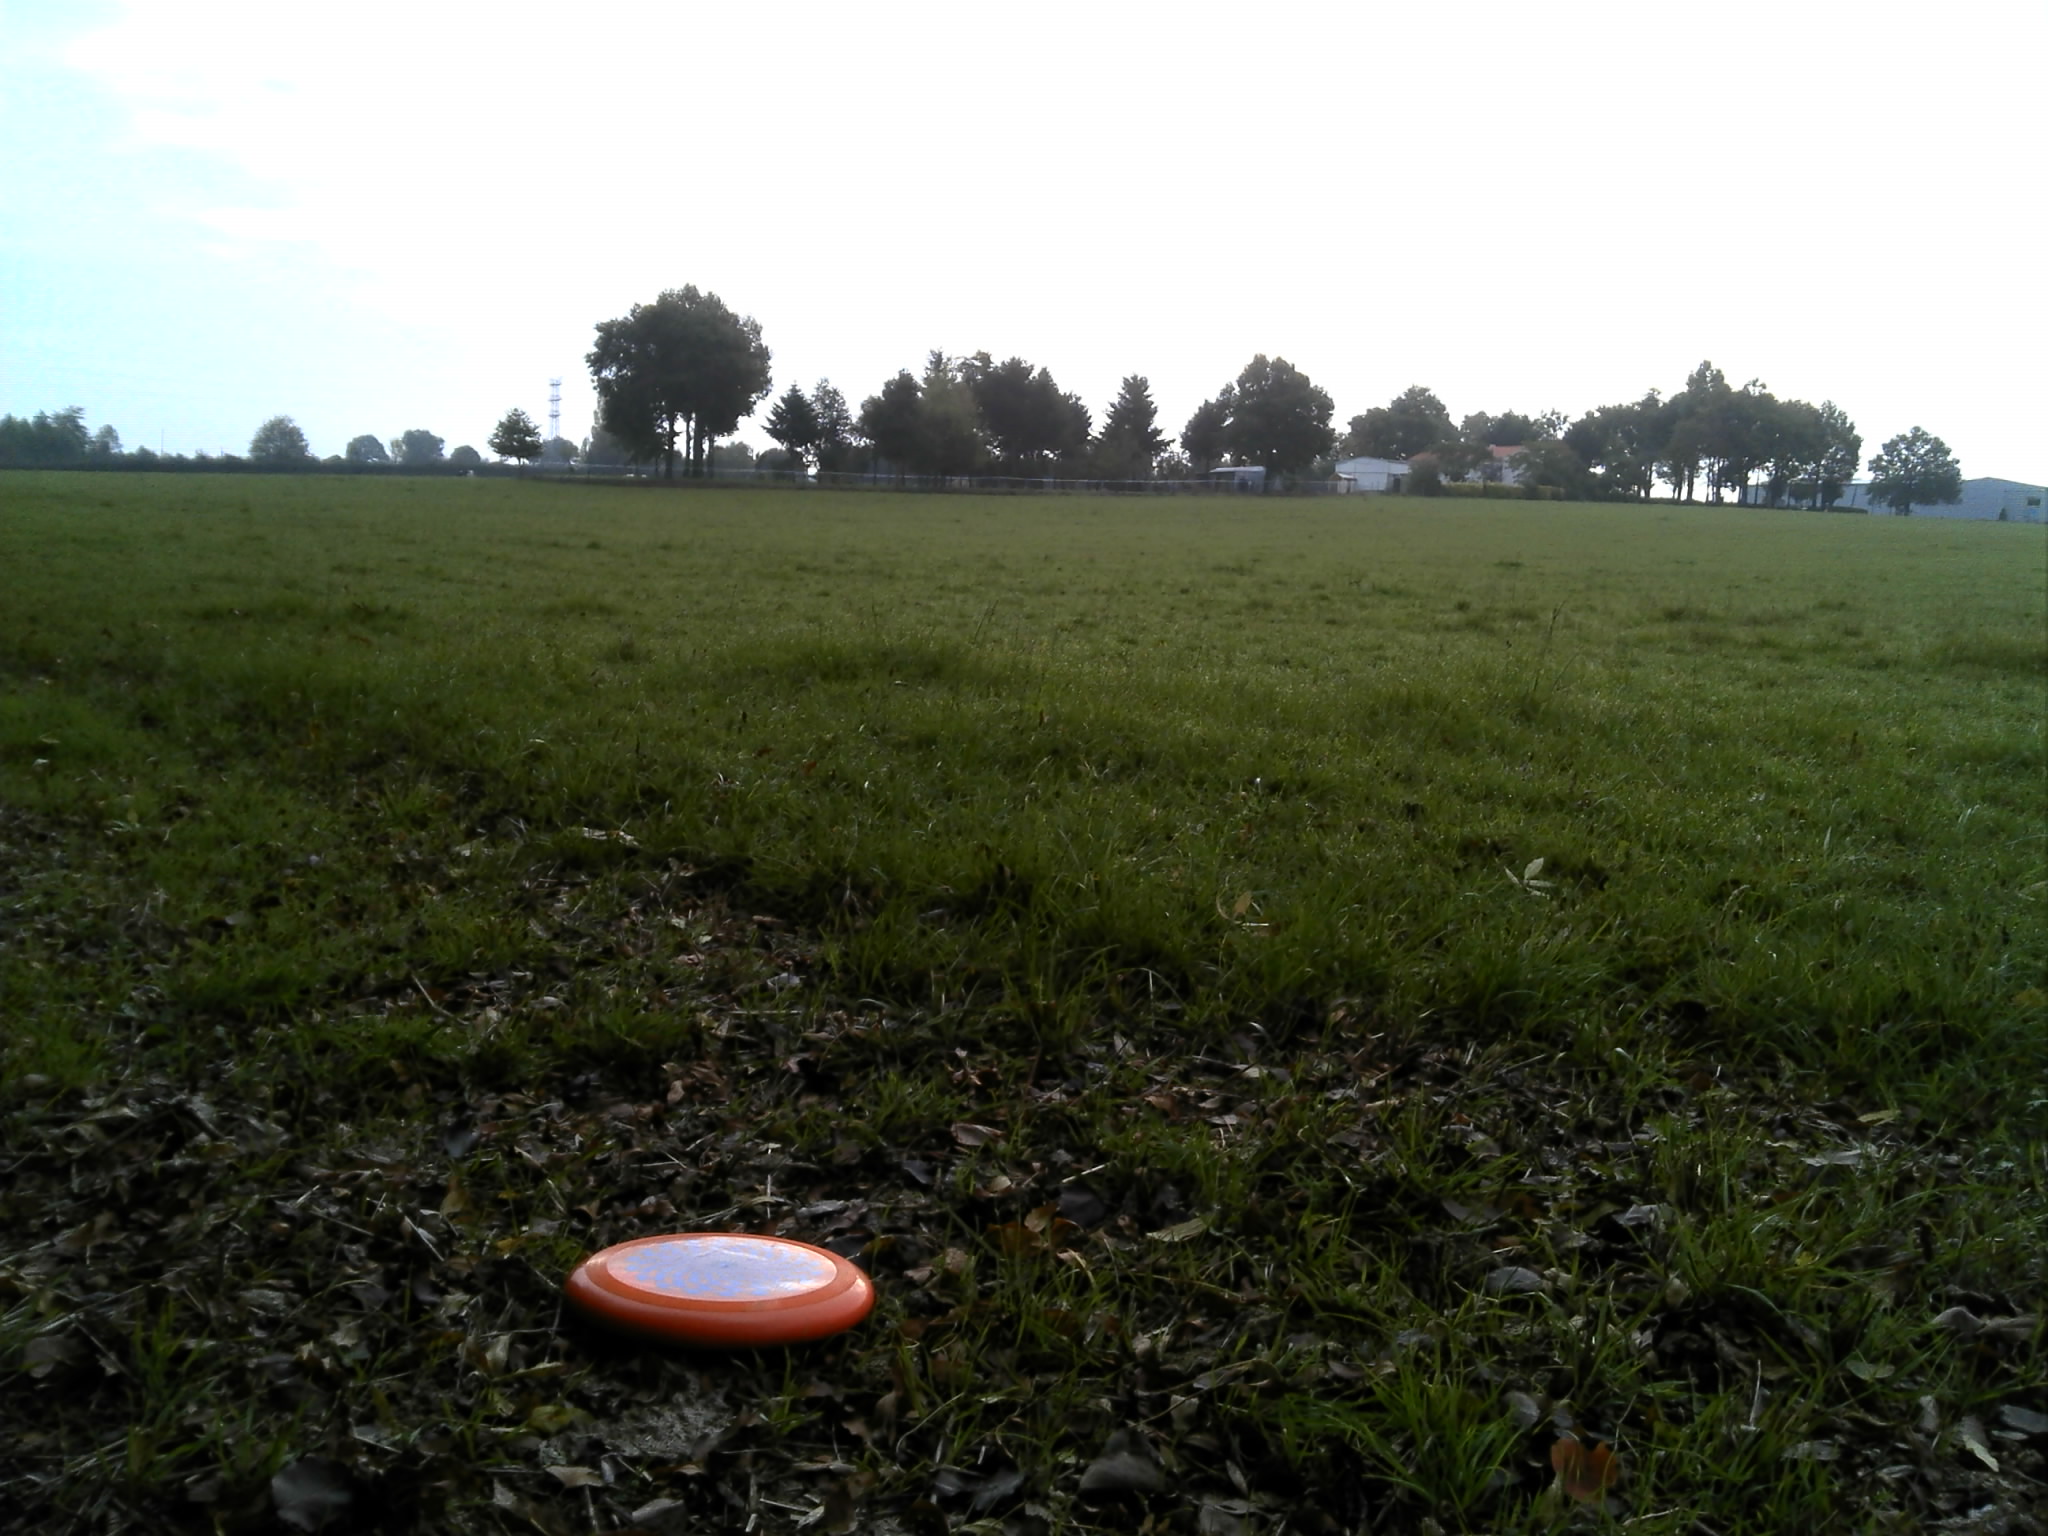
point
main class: Cropland
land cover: Temporary grasslands
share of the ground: > 75 %
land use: Agriculture (excluding fallow land and kitchen gardens)
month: October
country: FR
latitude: 47.2928
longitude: -0.9711
